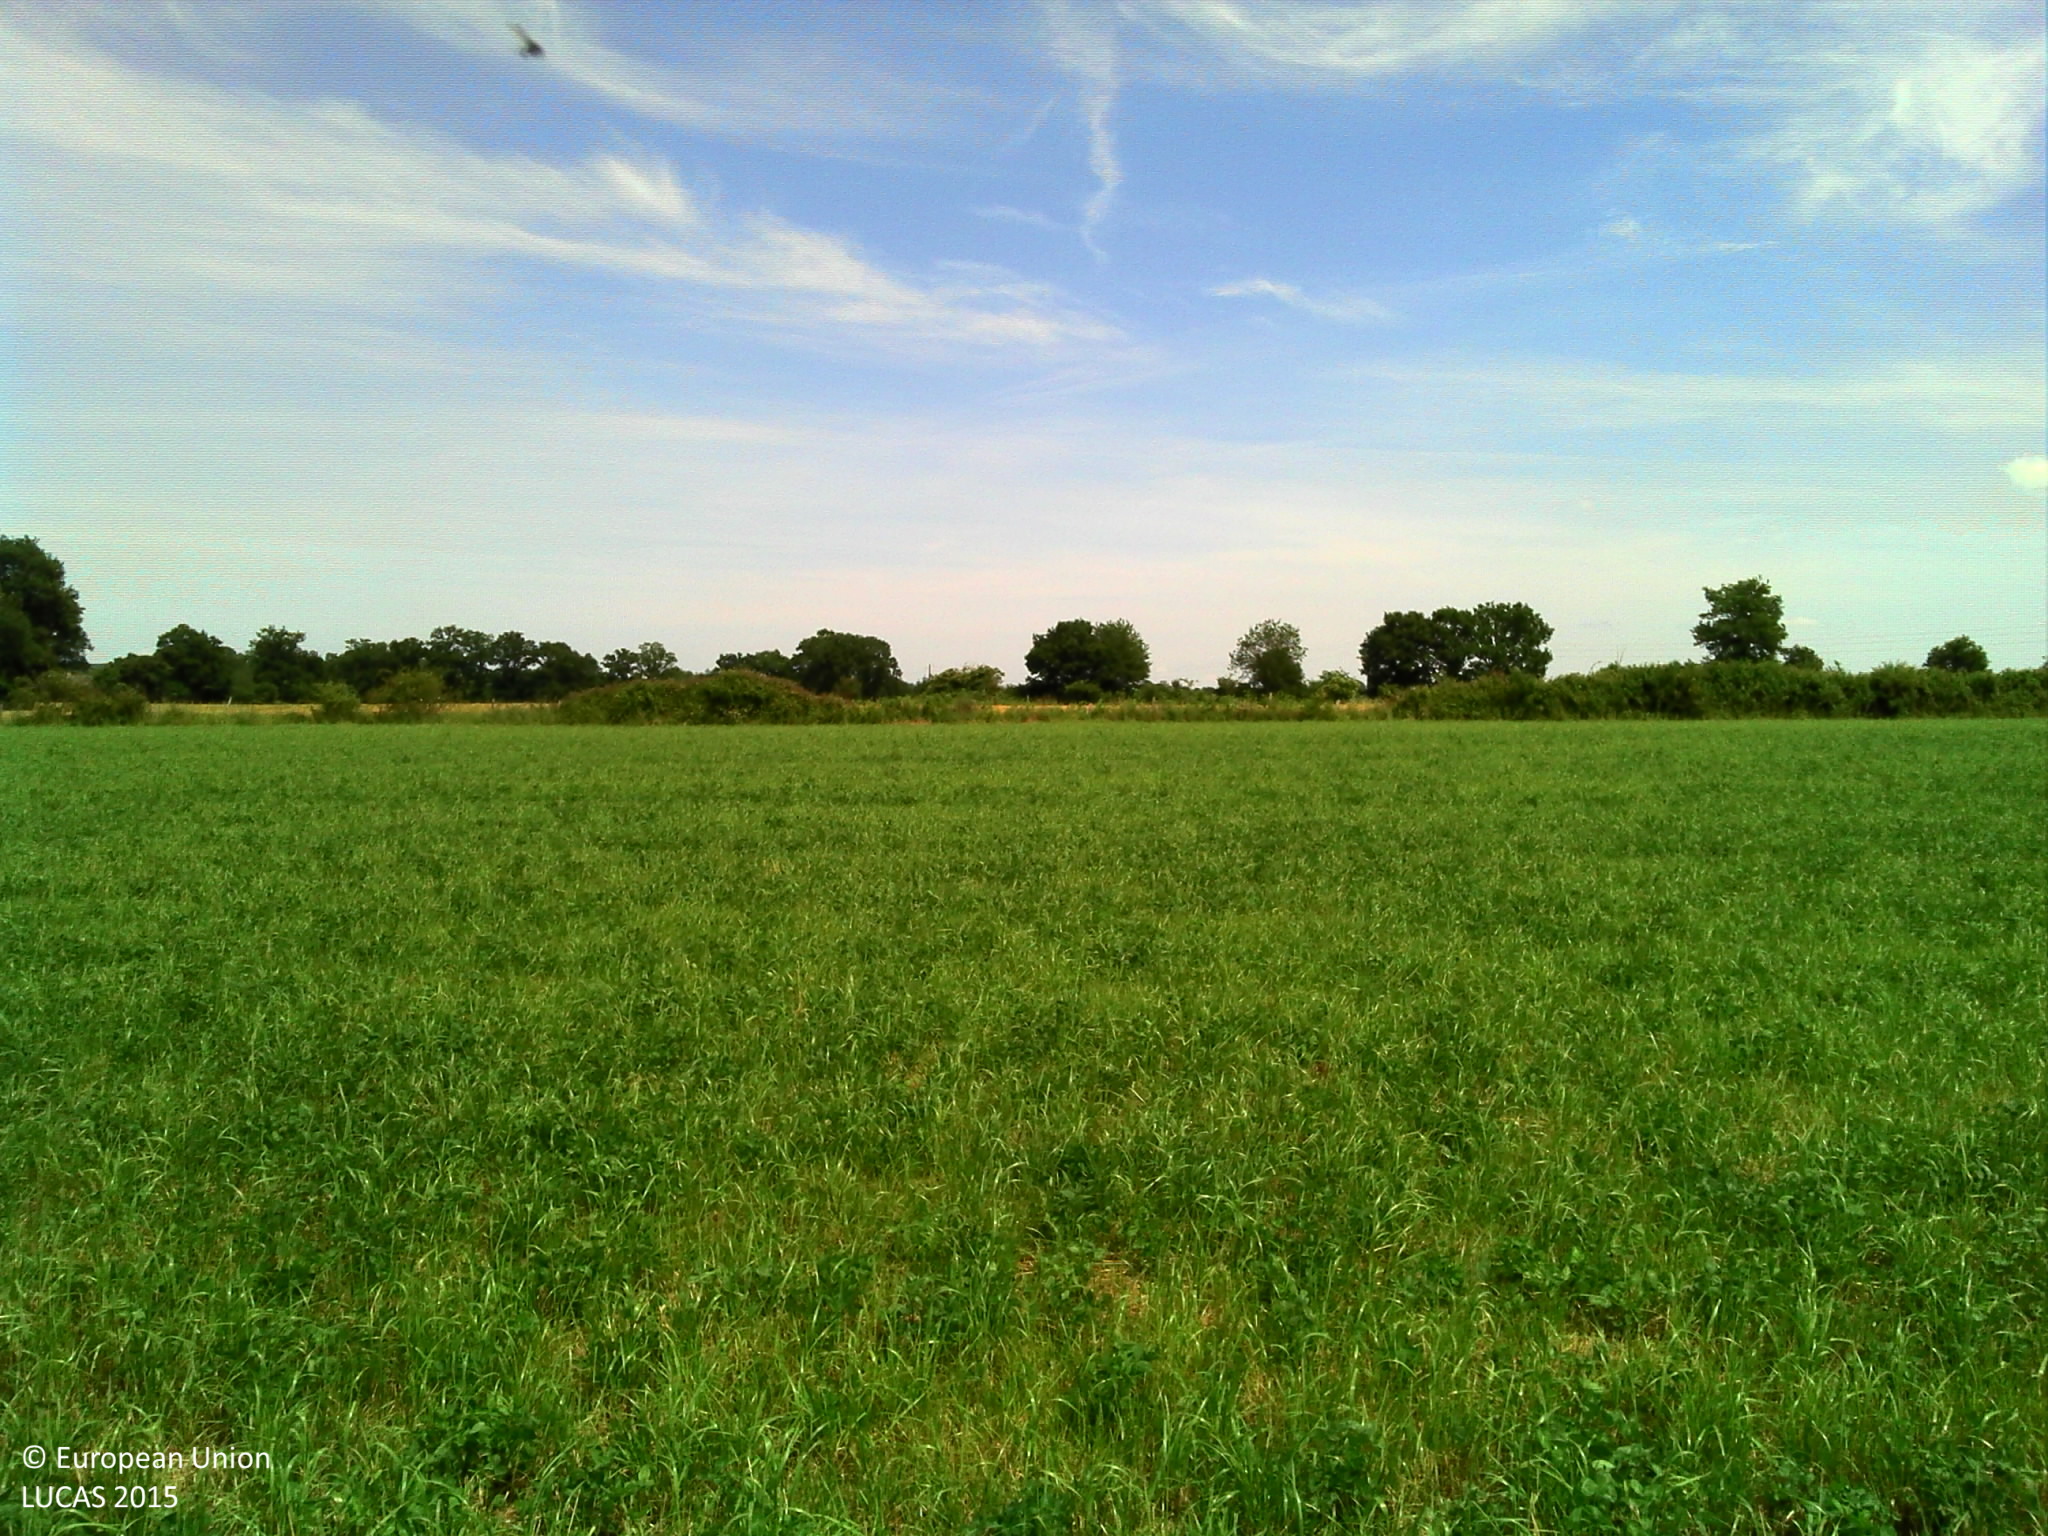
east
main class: Cropland
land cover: Temporary grasslands
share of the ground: > 75 %
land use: Agriculture (excluding fallow land and kitchen gardens)
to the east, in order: Temporary grasslands; Abandoned hedges; Fences; Tracks; Barley; Abandoned hedges; Grassland without tree/shrub cover; Lines of trees; Grassland without tree/shrub cover
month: June
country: FR
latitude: 48.3462
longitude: -1.5021
